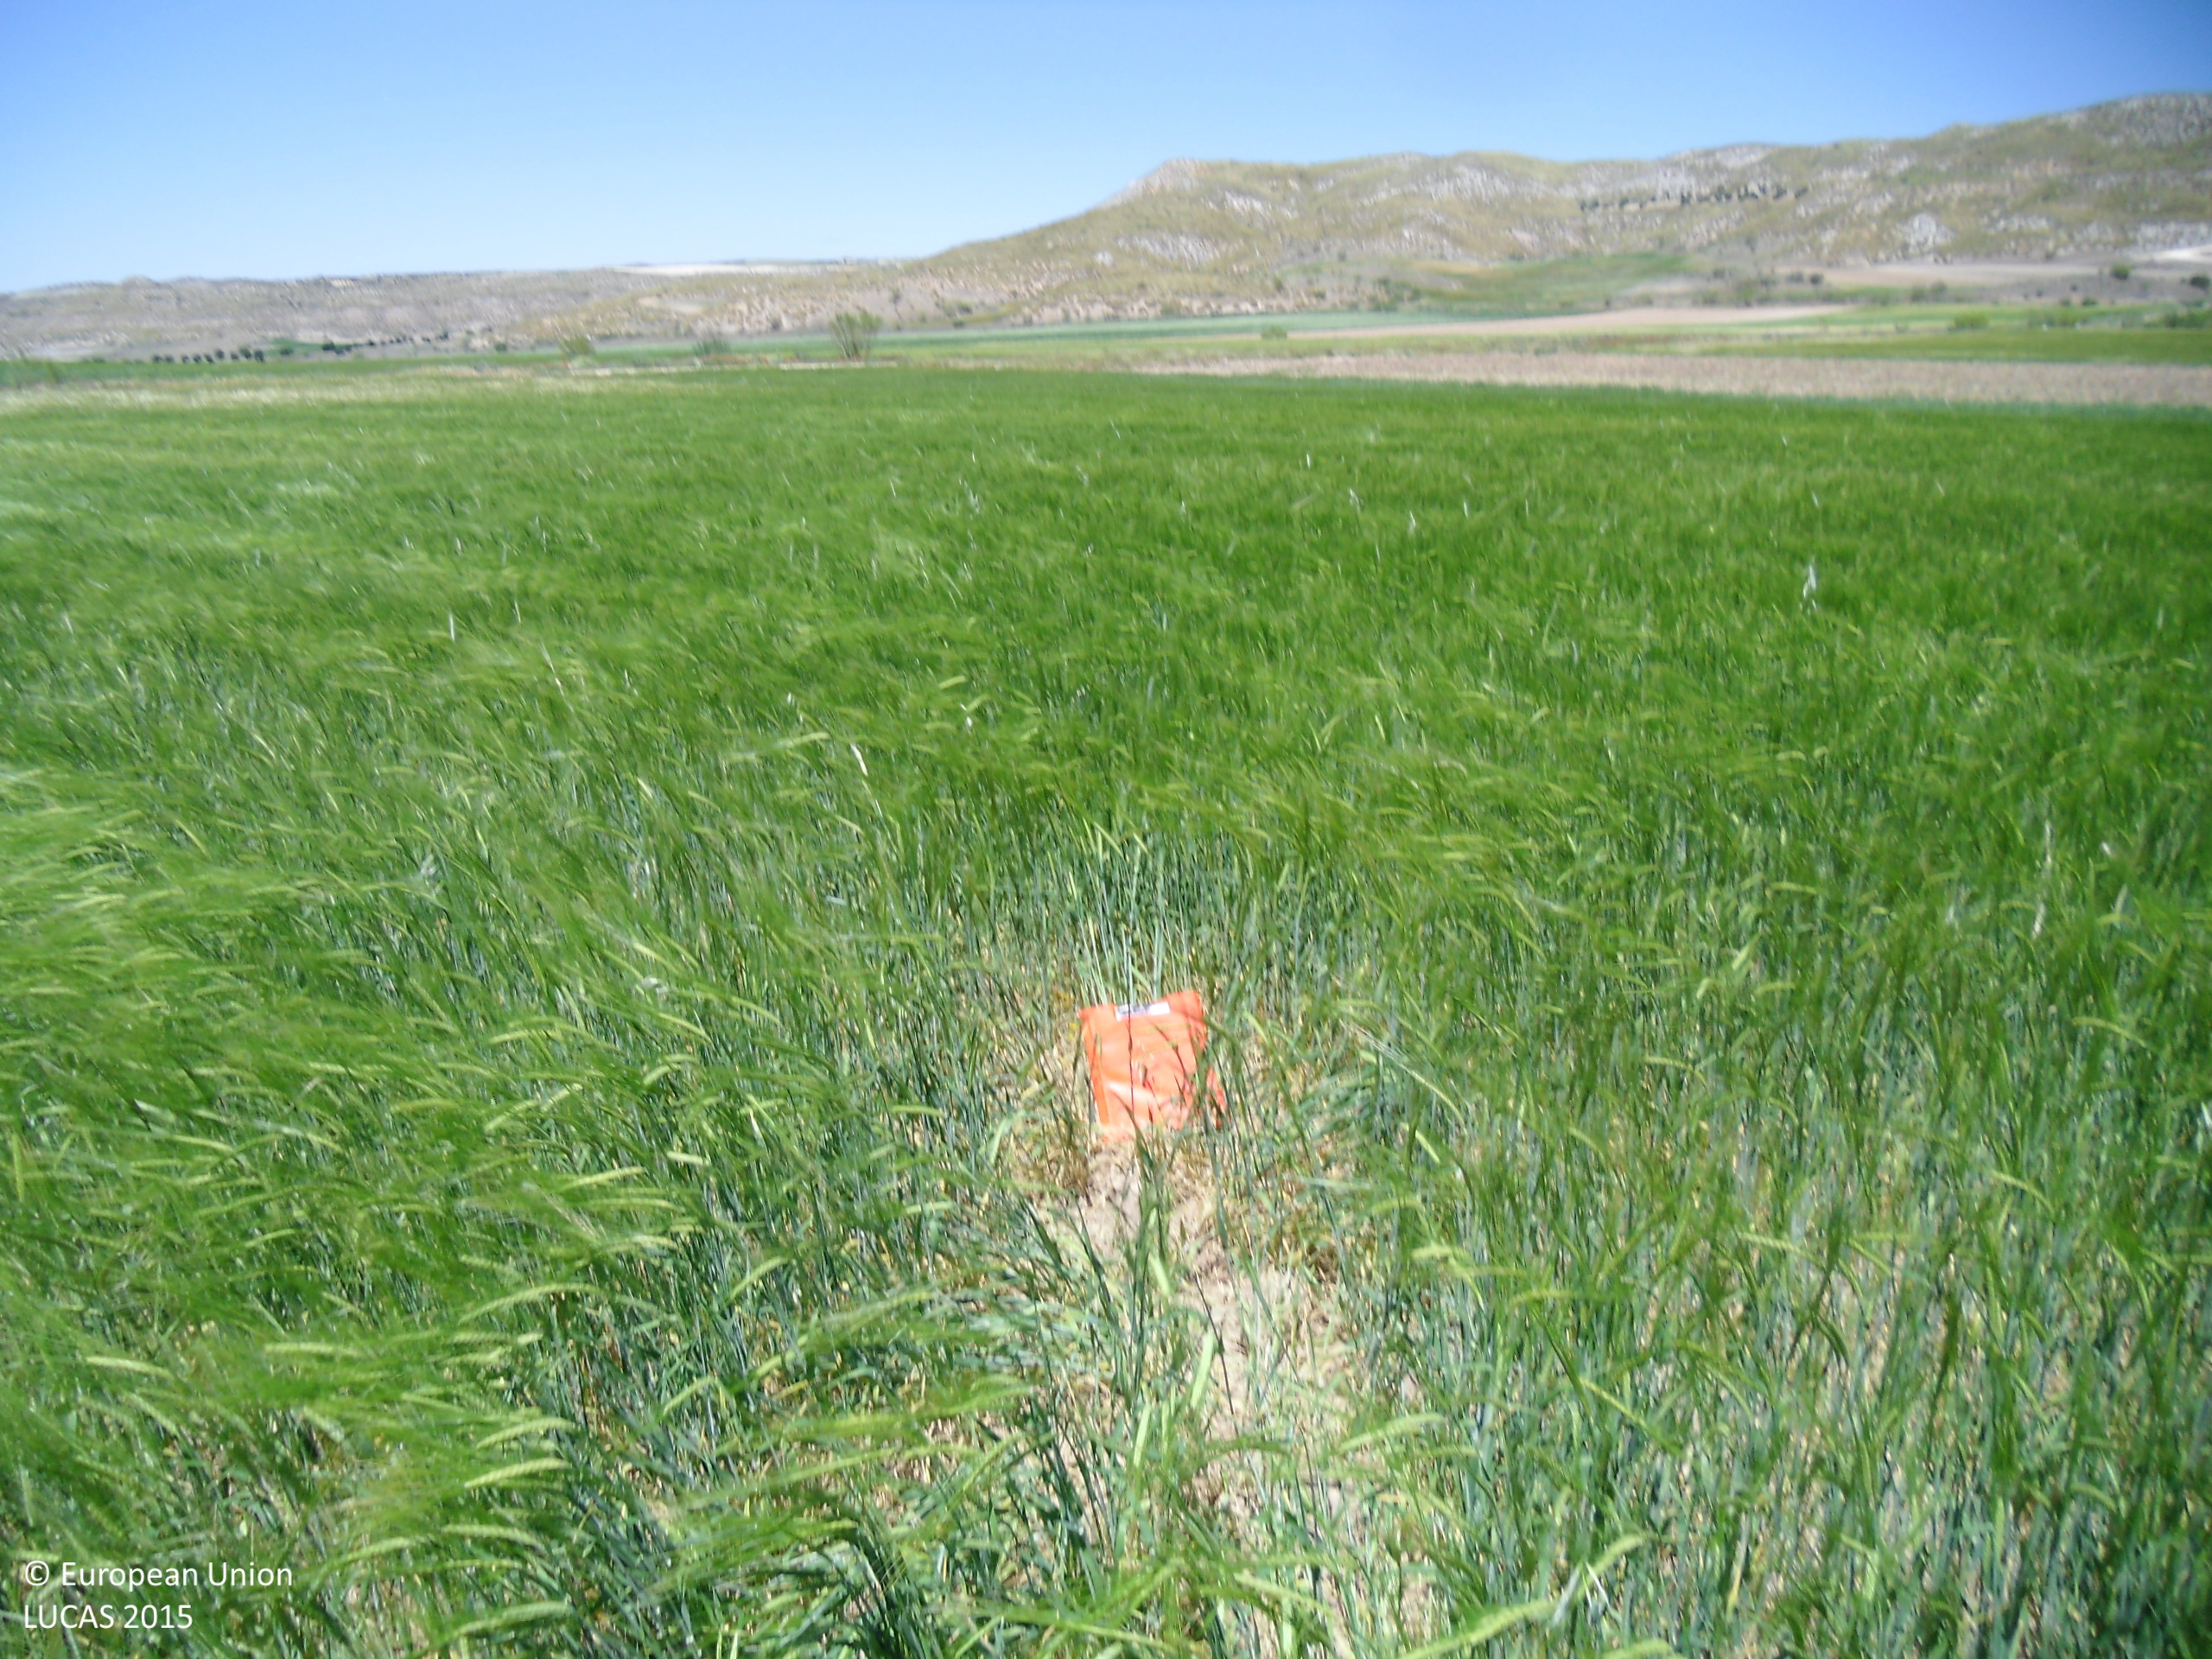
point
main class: Cropland
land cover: Barley
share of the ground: > 75 %
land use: Agriculture (excluding fallow land and kitchen gardens)
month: May
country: ES
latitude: 40.1761
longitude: -2.9311
